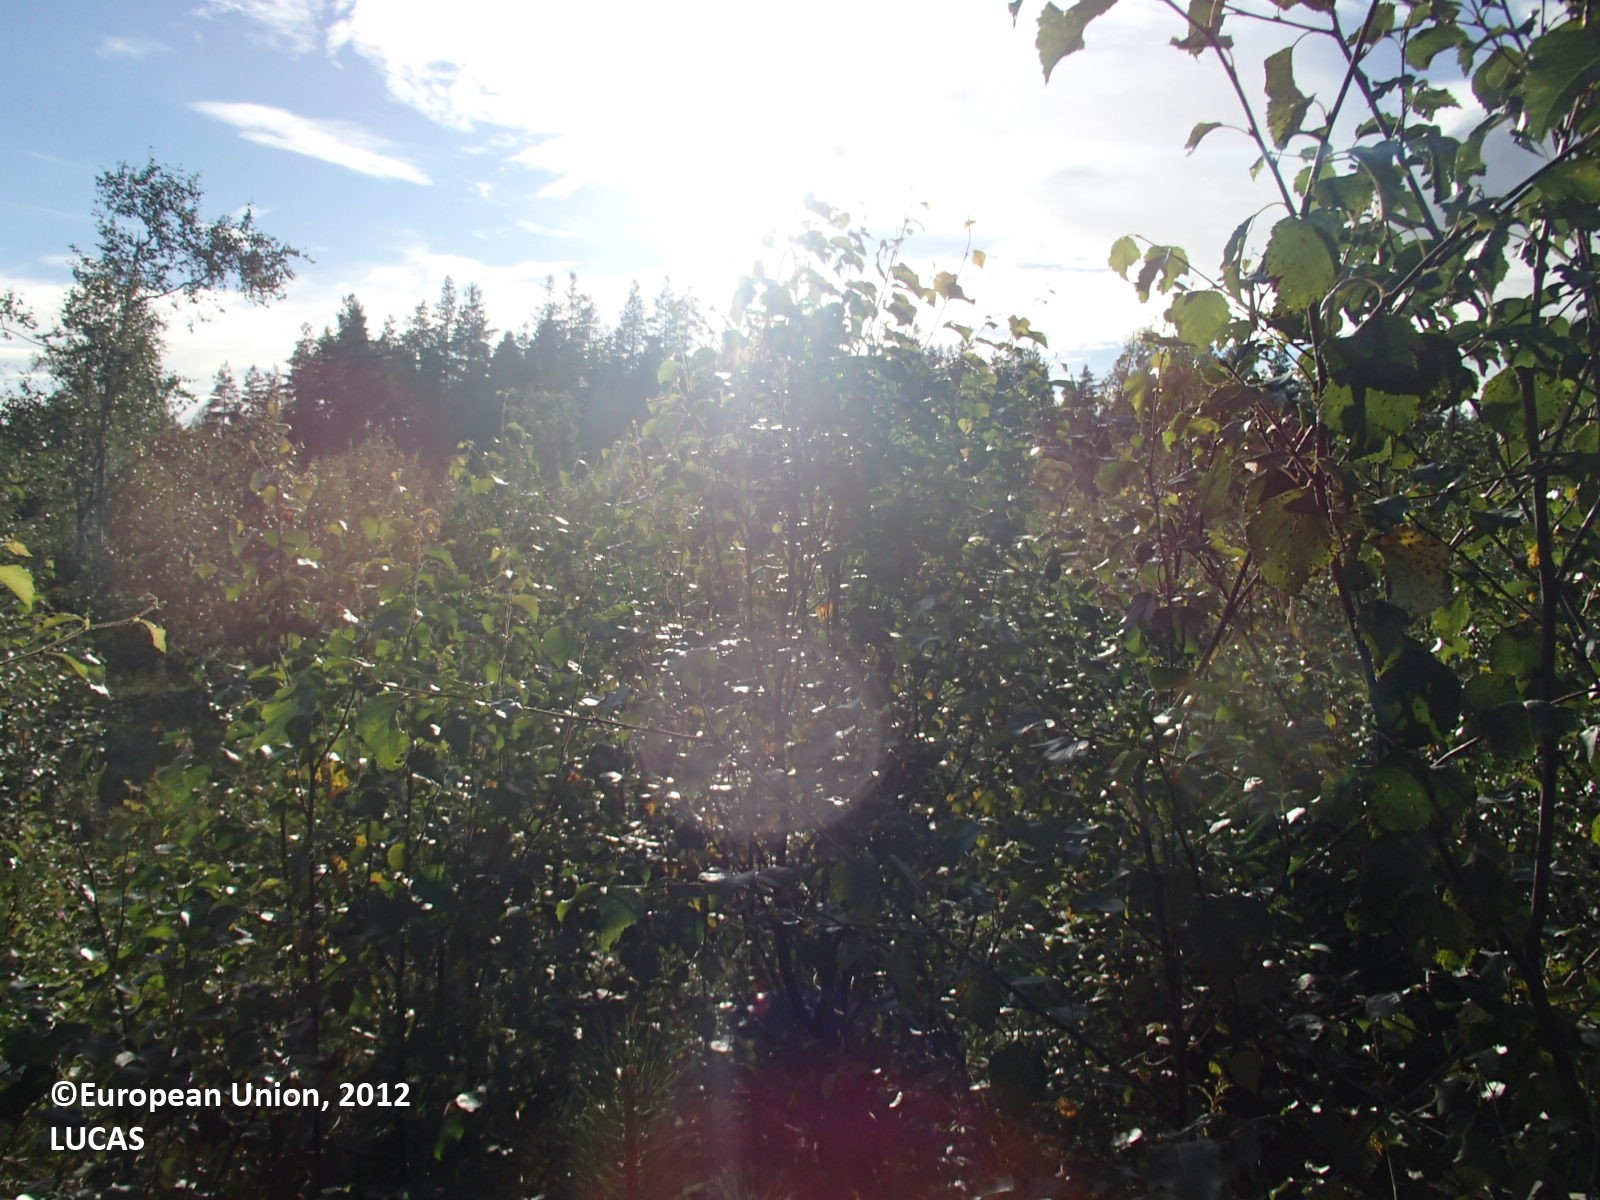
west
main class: Woodland
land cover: Other mixed woodland
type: boreal forest
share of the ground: > 75 %
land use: Forestry
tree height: < 5 m
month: August
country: FI
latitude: 63.8130
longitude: 28.0636
